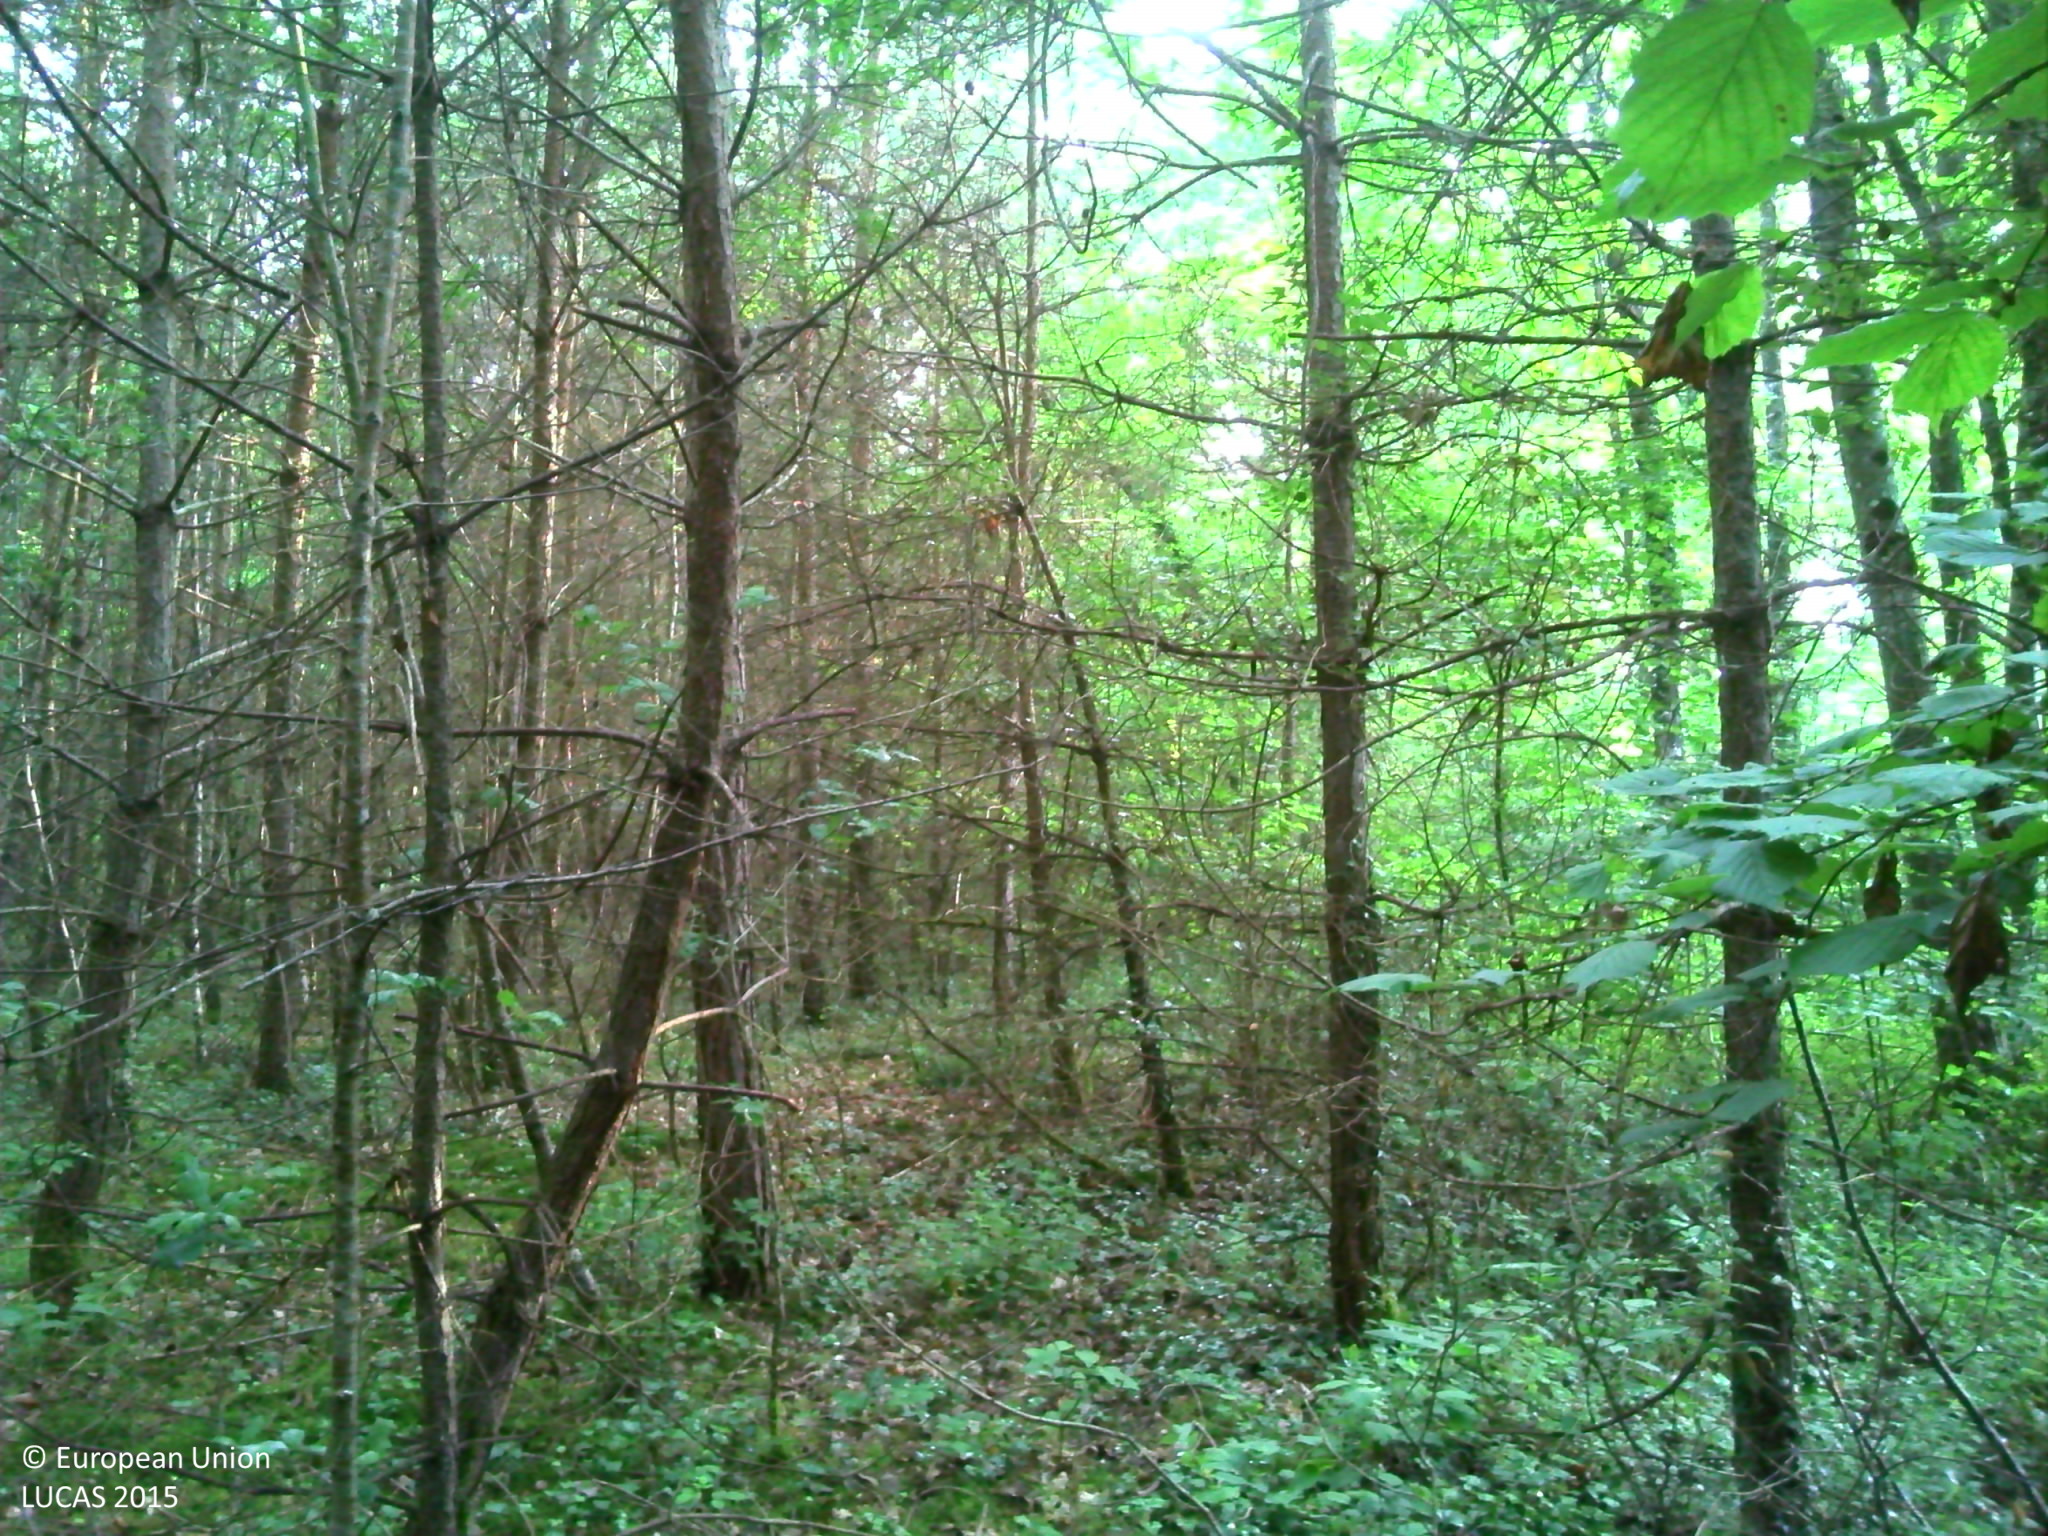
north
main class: Woodland
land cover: Pine dominated mixed woodland
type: hemiboreal forest and nemoral coniferous forest and mixed broadleaved-coniferous forest
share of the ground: > 75 %
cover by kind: coniferous forest trees 45 %, broadleaved forest trees 45 %, herbaceous plants 10 %
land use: Forestry
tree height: > 5 m
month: June
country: FR
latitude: 47.7178
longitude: 2.0306
